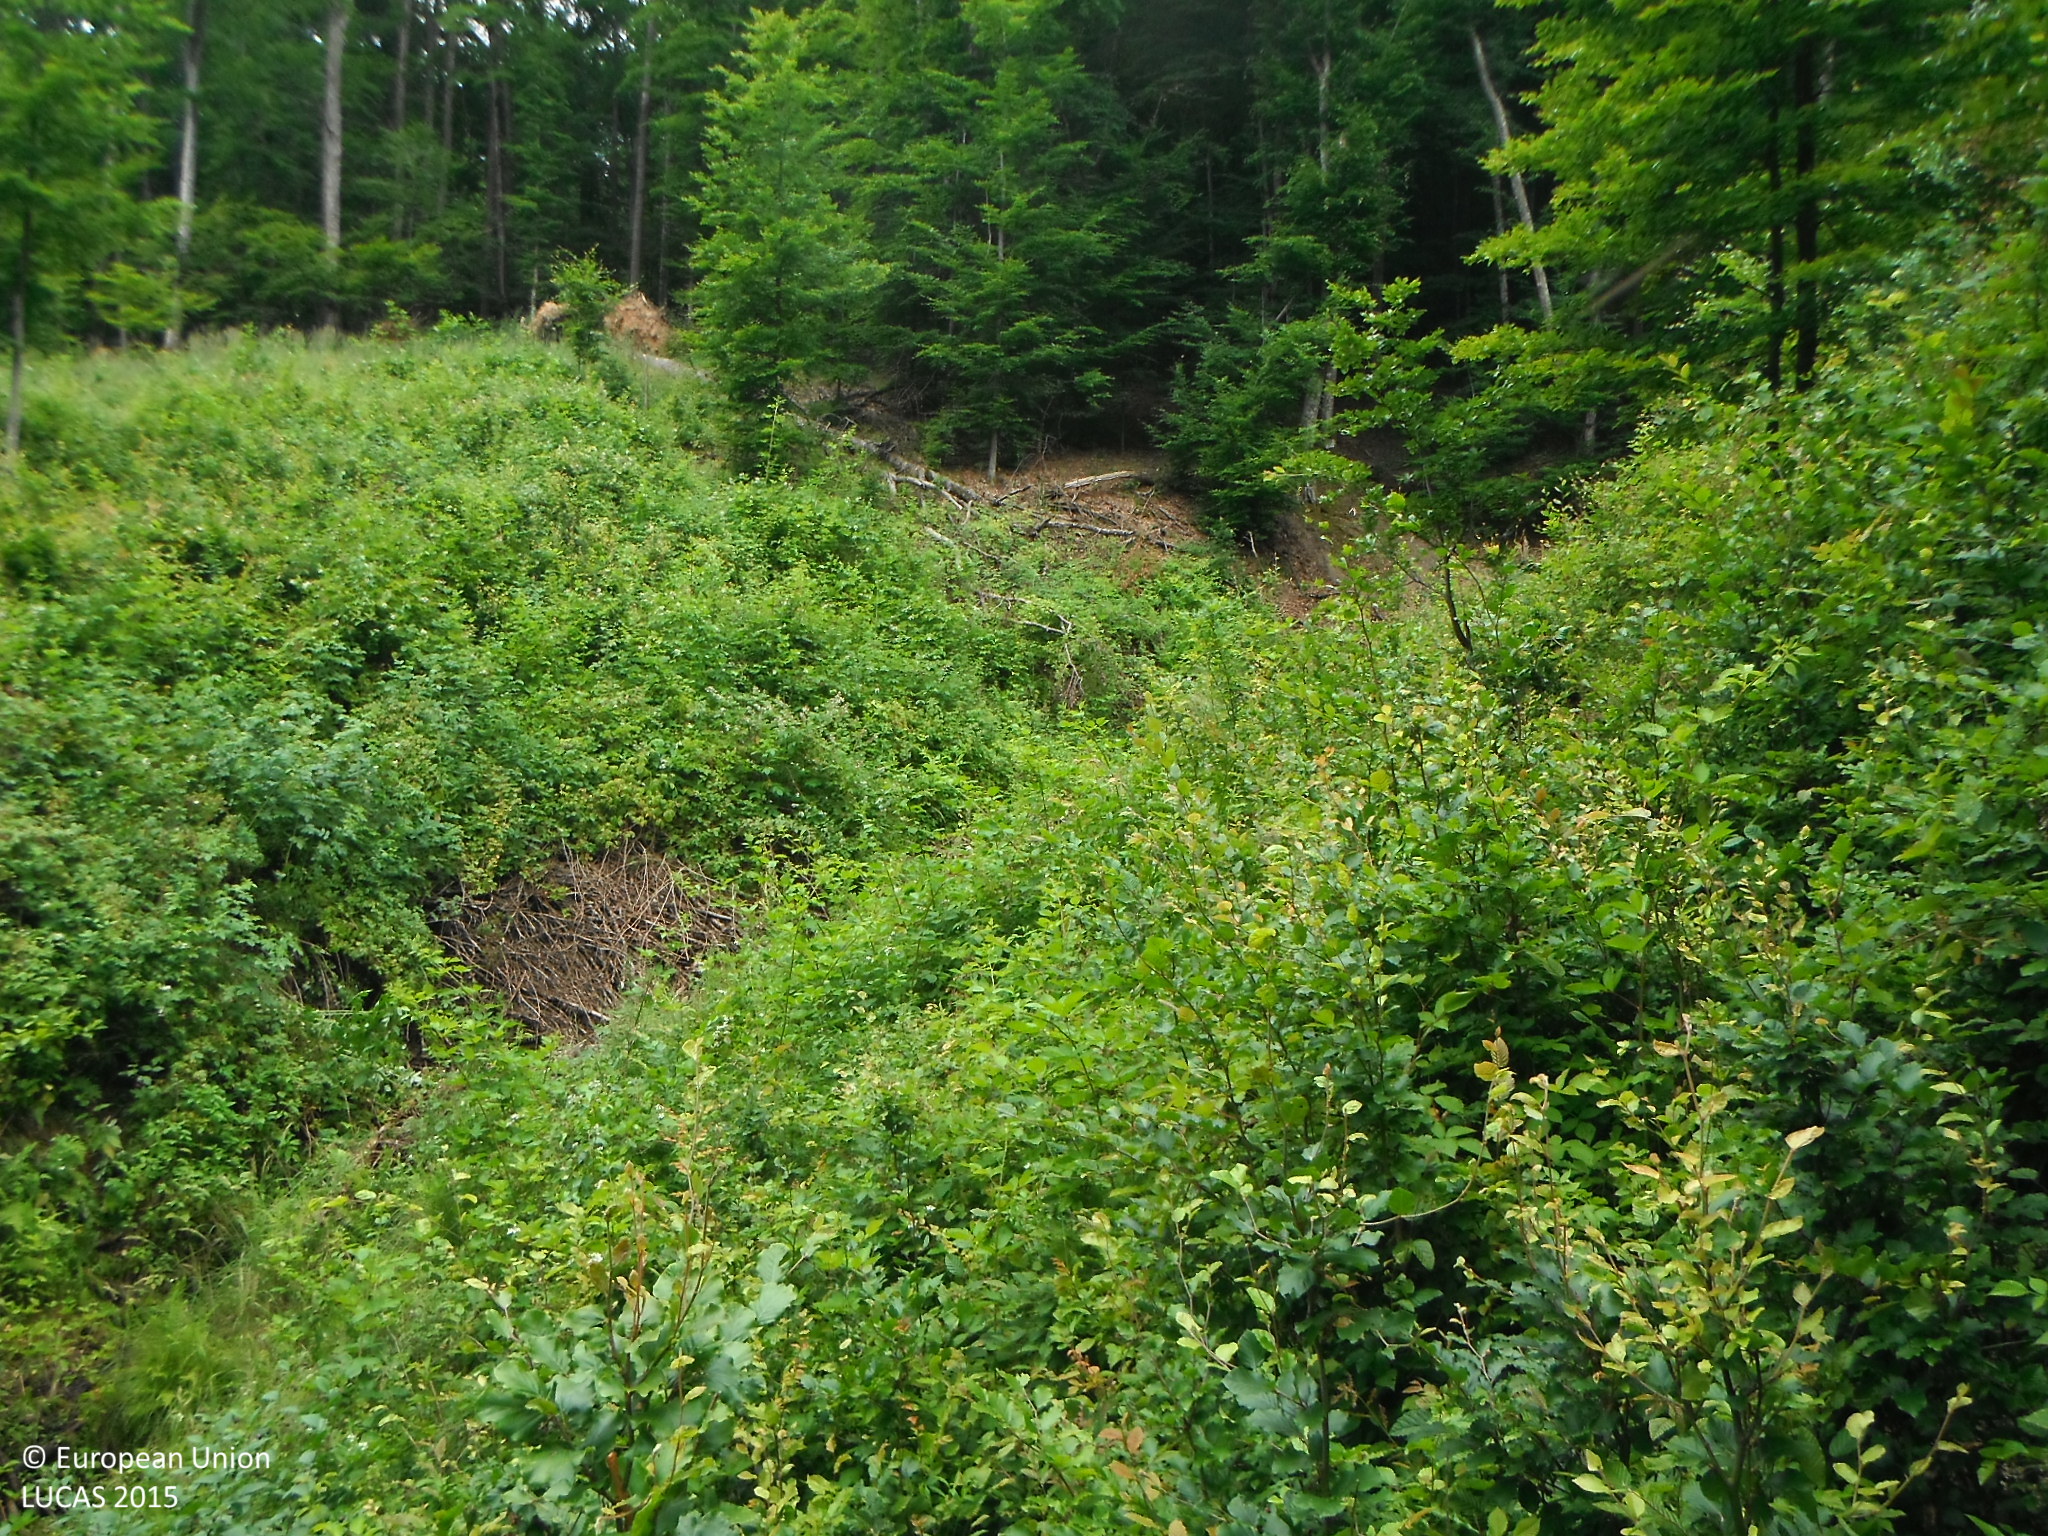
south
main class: Woodland
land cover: Broadleaved woodland
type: beech forest
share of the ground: > 75 %
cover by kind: broadleaved forest trees 90 %, shrubs 10 %
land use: Forestry
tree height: < 5 m
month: July
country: SK
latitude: 48.5872
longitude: 20.1585
